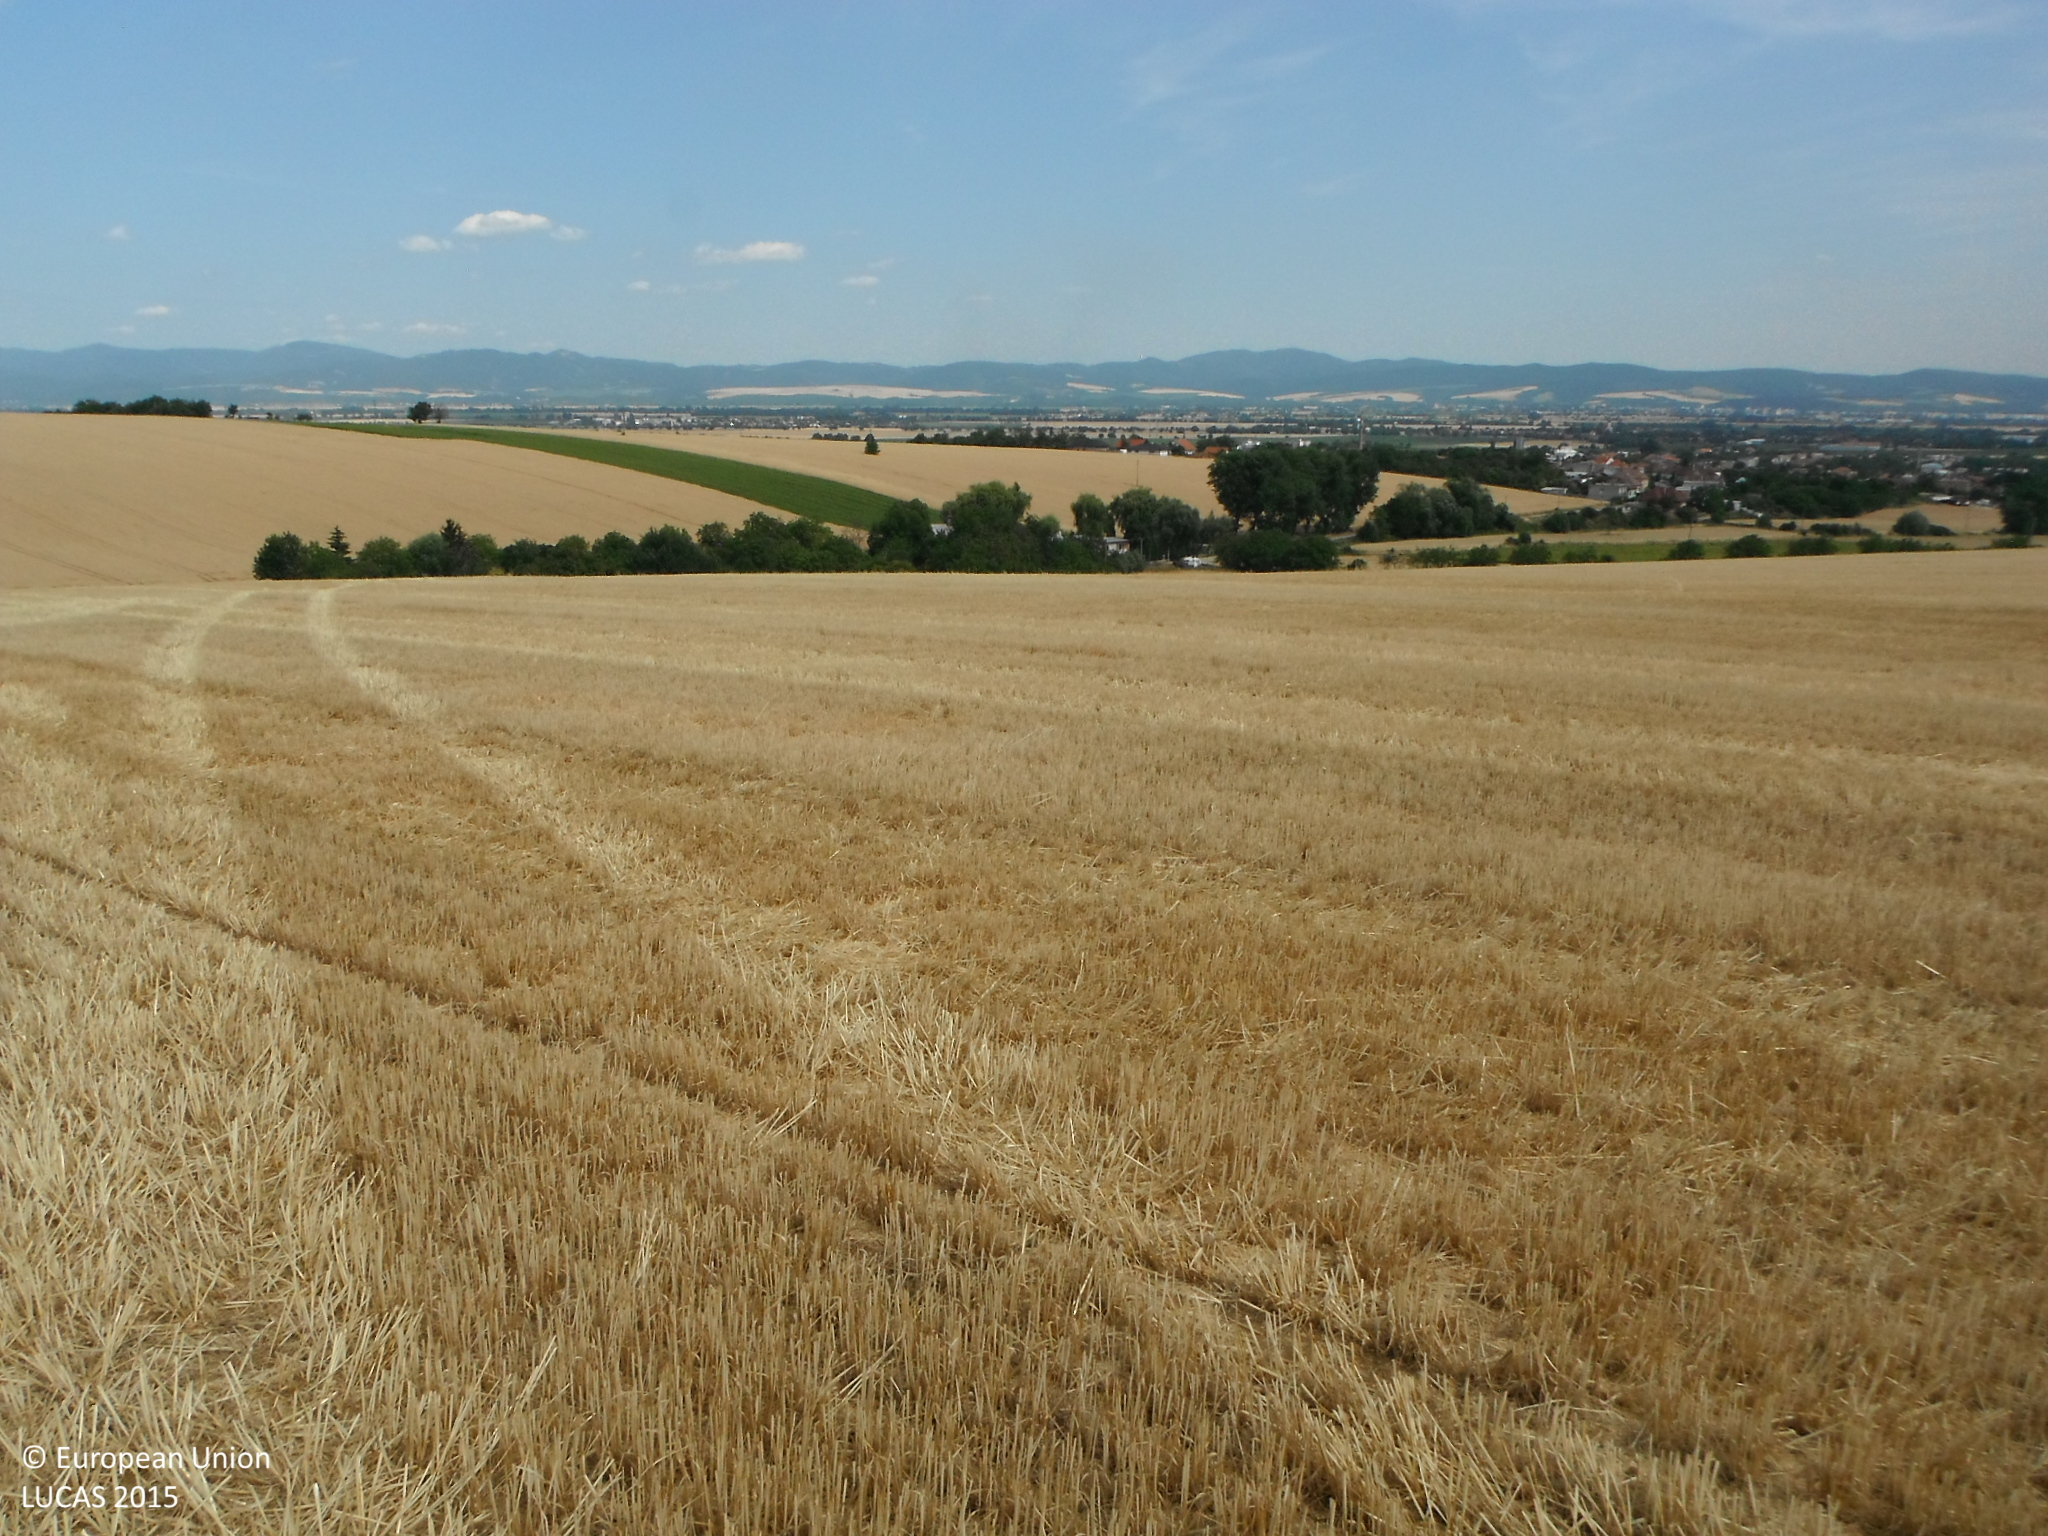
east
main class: Cropland
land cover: Barley
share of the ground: > 75 %
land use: Agriculture (excluding fallow land and kitchen gardens)
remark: Harvested field
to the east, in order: Barley; Spontaneously vegetated surfaces; Artificial constructions in urban areas
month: July
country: SK
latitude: 48.6224
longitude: 17.7042
